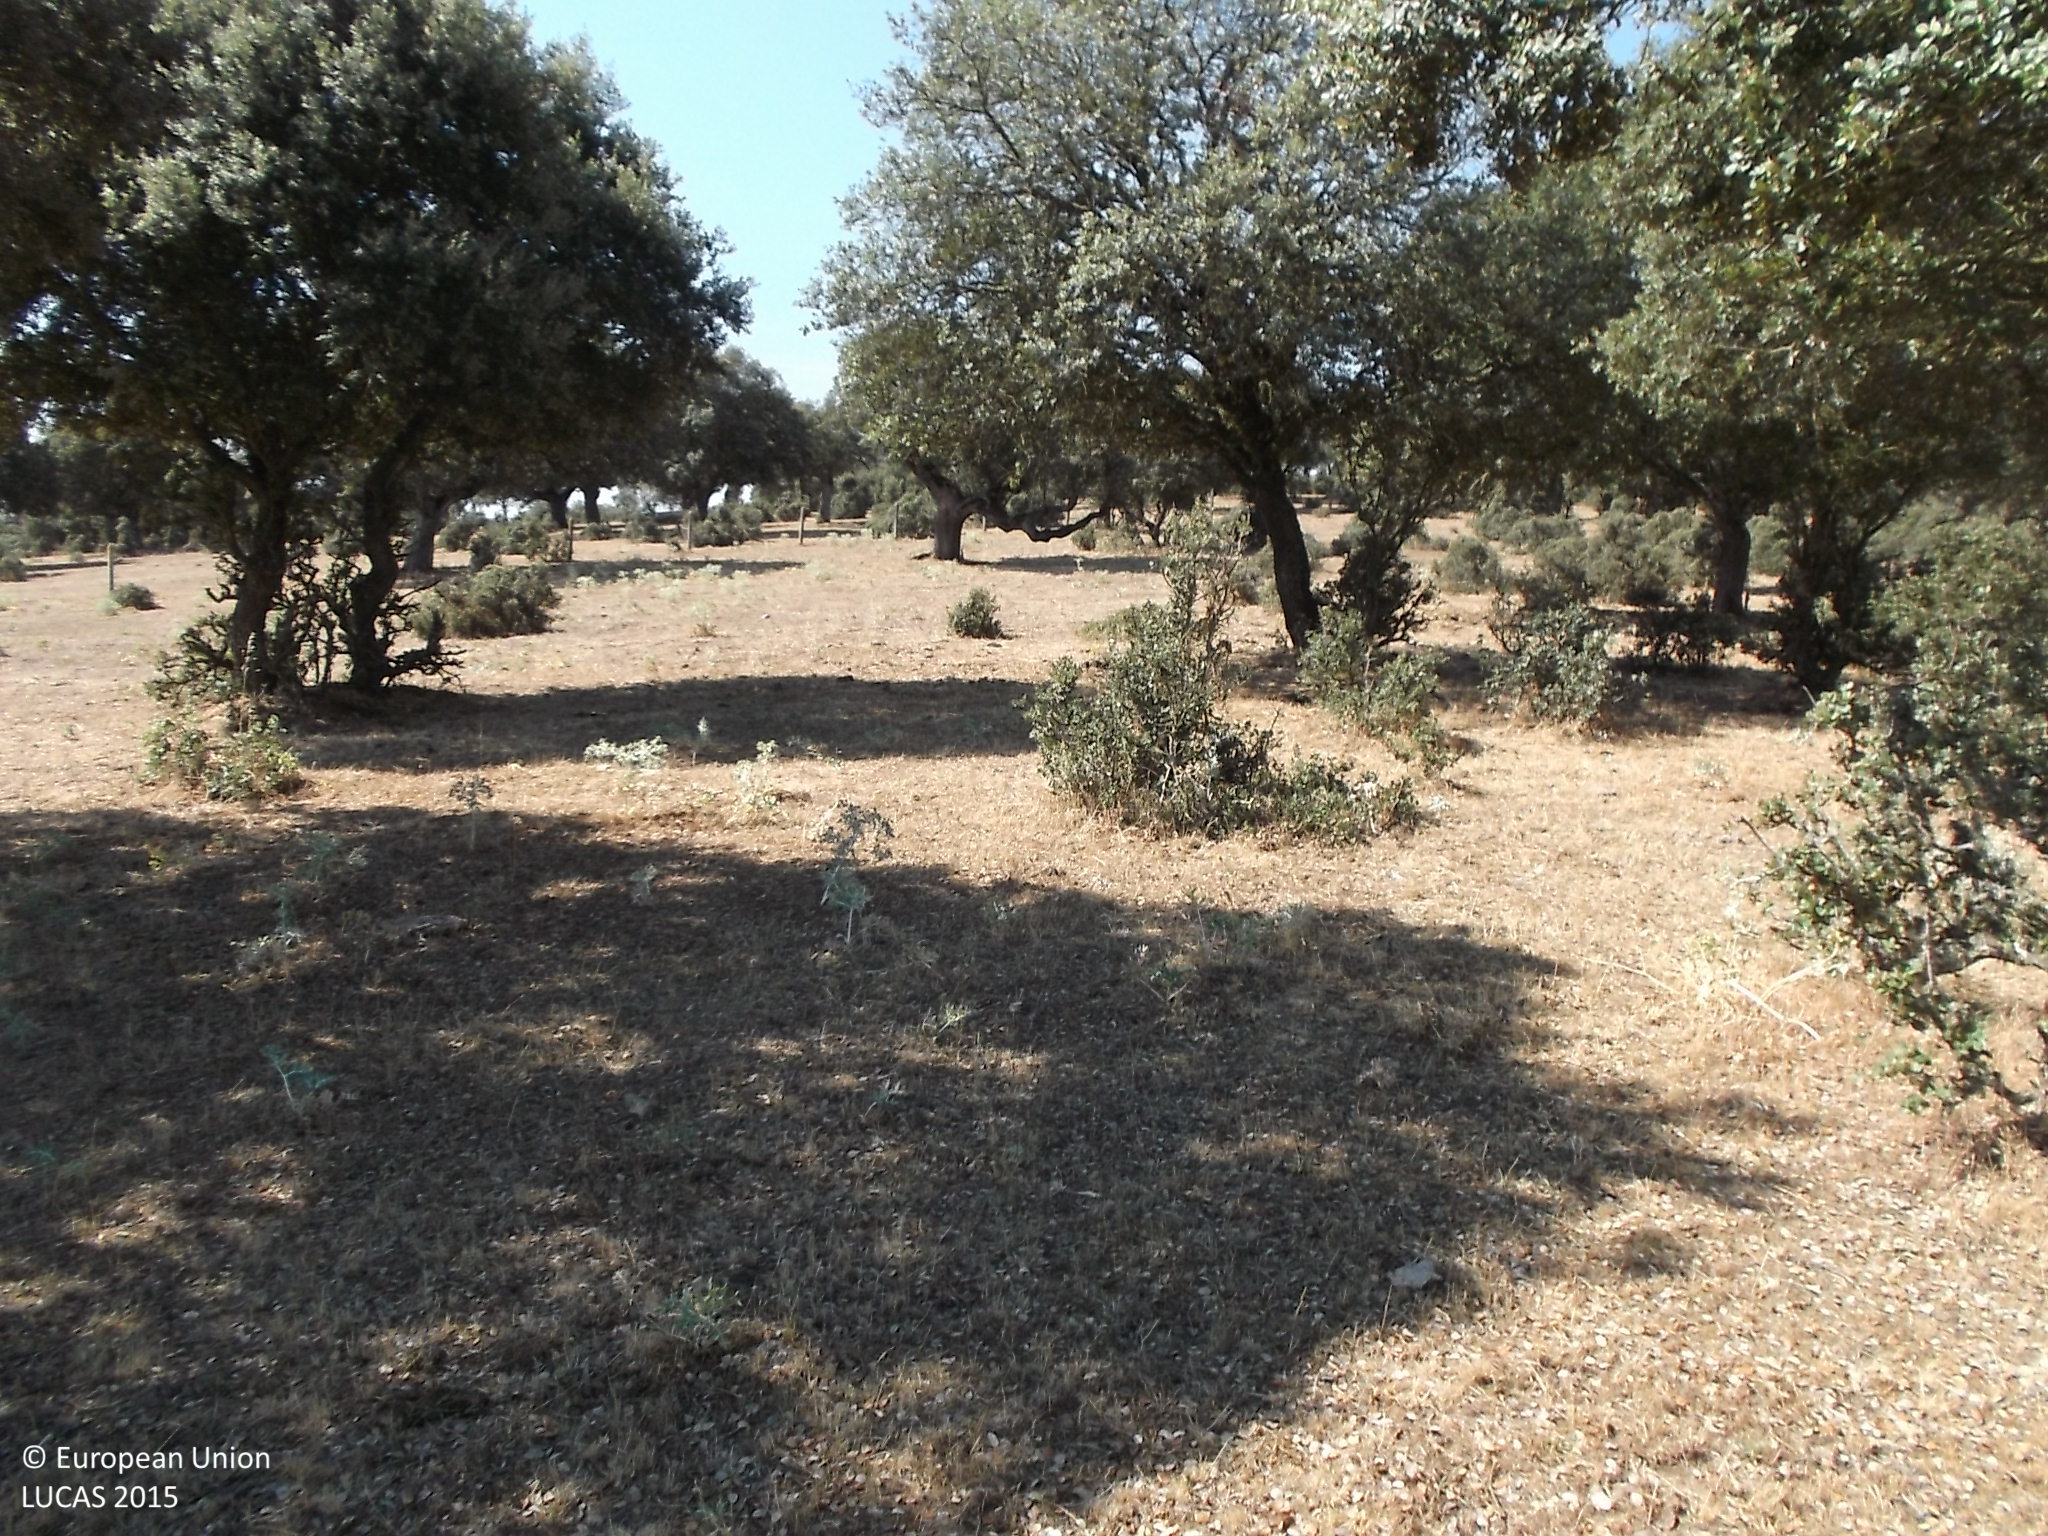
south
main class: Woodland
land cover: Broadleaved woodland
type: broadleaved evergreen forest
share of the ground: 25 - 50 %
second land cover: Shrubland without tree cover
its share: 50 - 75 %
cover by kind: herbaceous plants 40 %, broadleaved forest trees 30 %, shrubs 30 %
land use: Forestry
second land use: Agriculture (excluding fallow land and kitchen gardens)
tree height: < 5 m
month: July
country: ES
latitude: 41.1957
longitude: -5.9571
